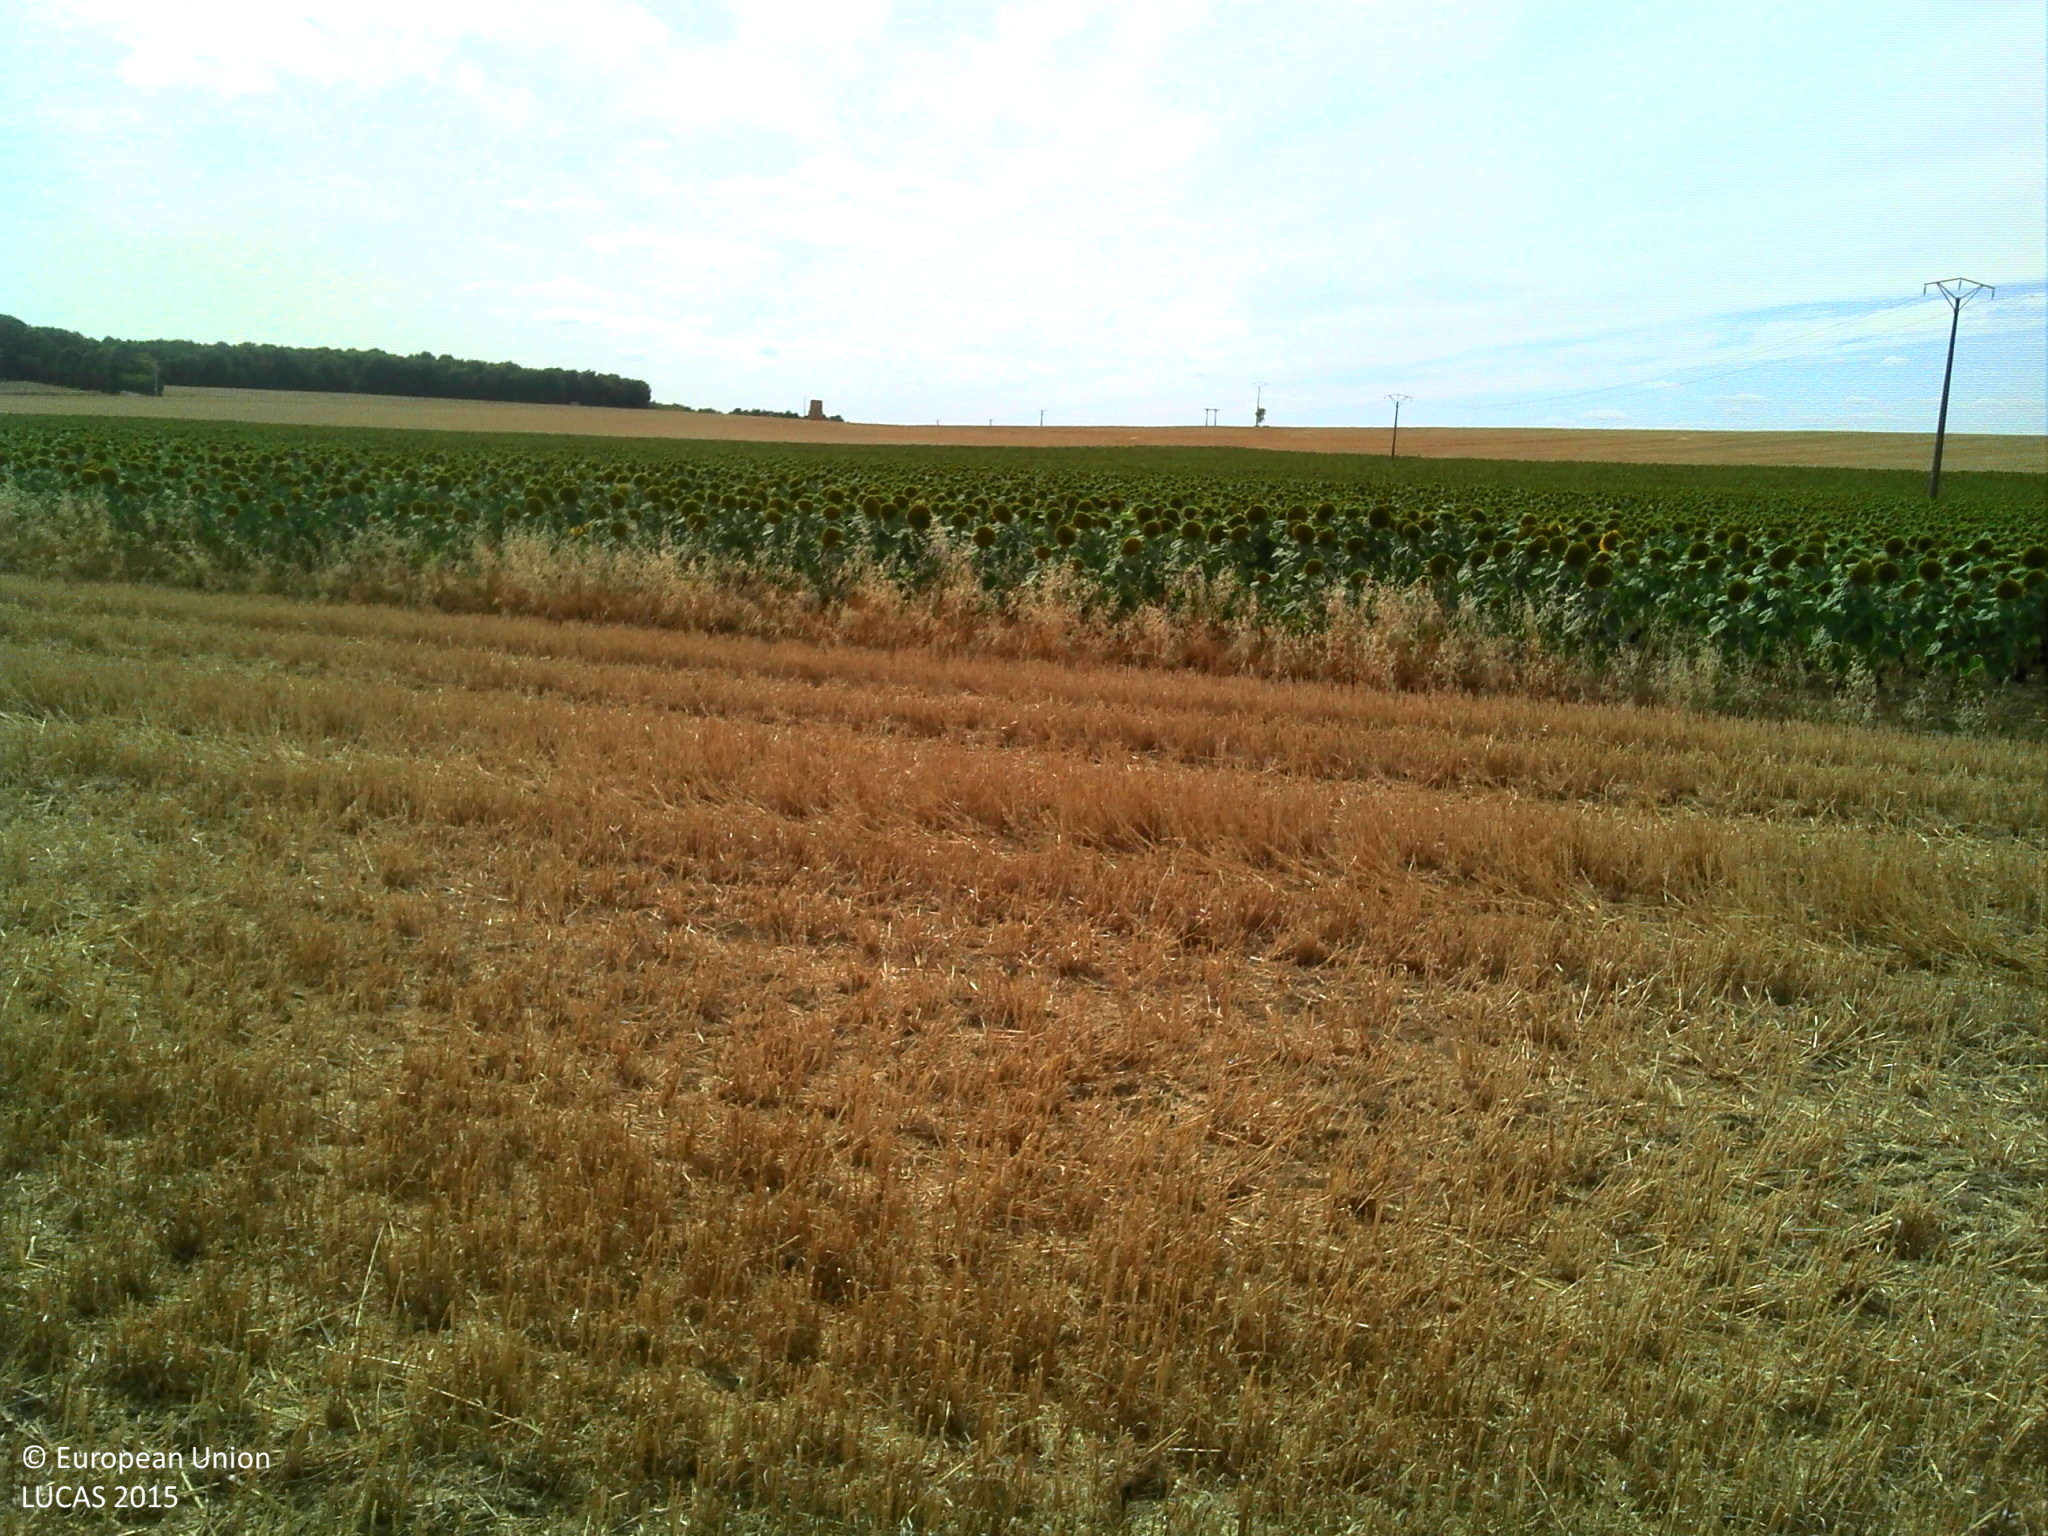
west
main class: Cropland
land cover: Common wheat
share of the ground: > 75 %
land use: Agriculture (excluding fallow land and kitchen gardens)
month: July
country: FR
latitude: 47.0382
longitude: 2.1347
